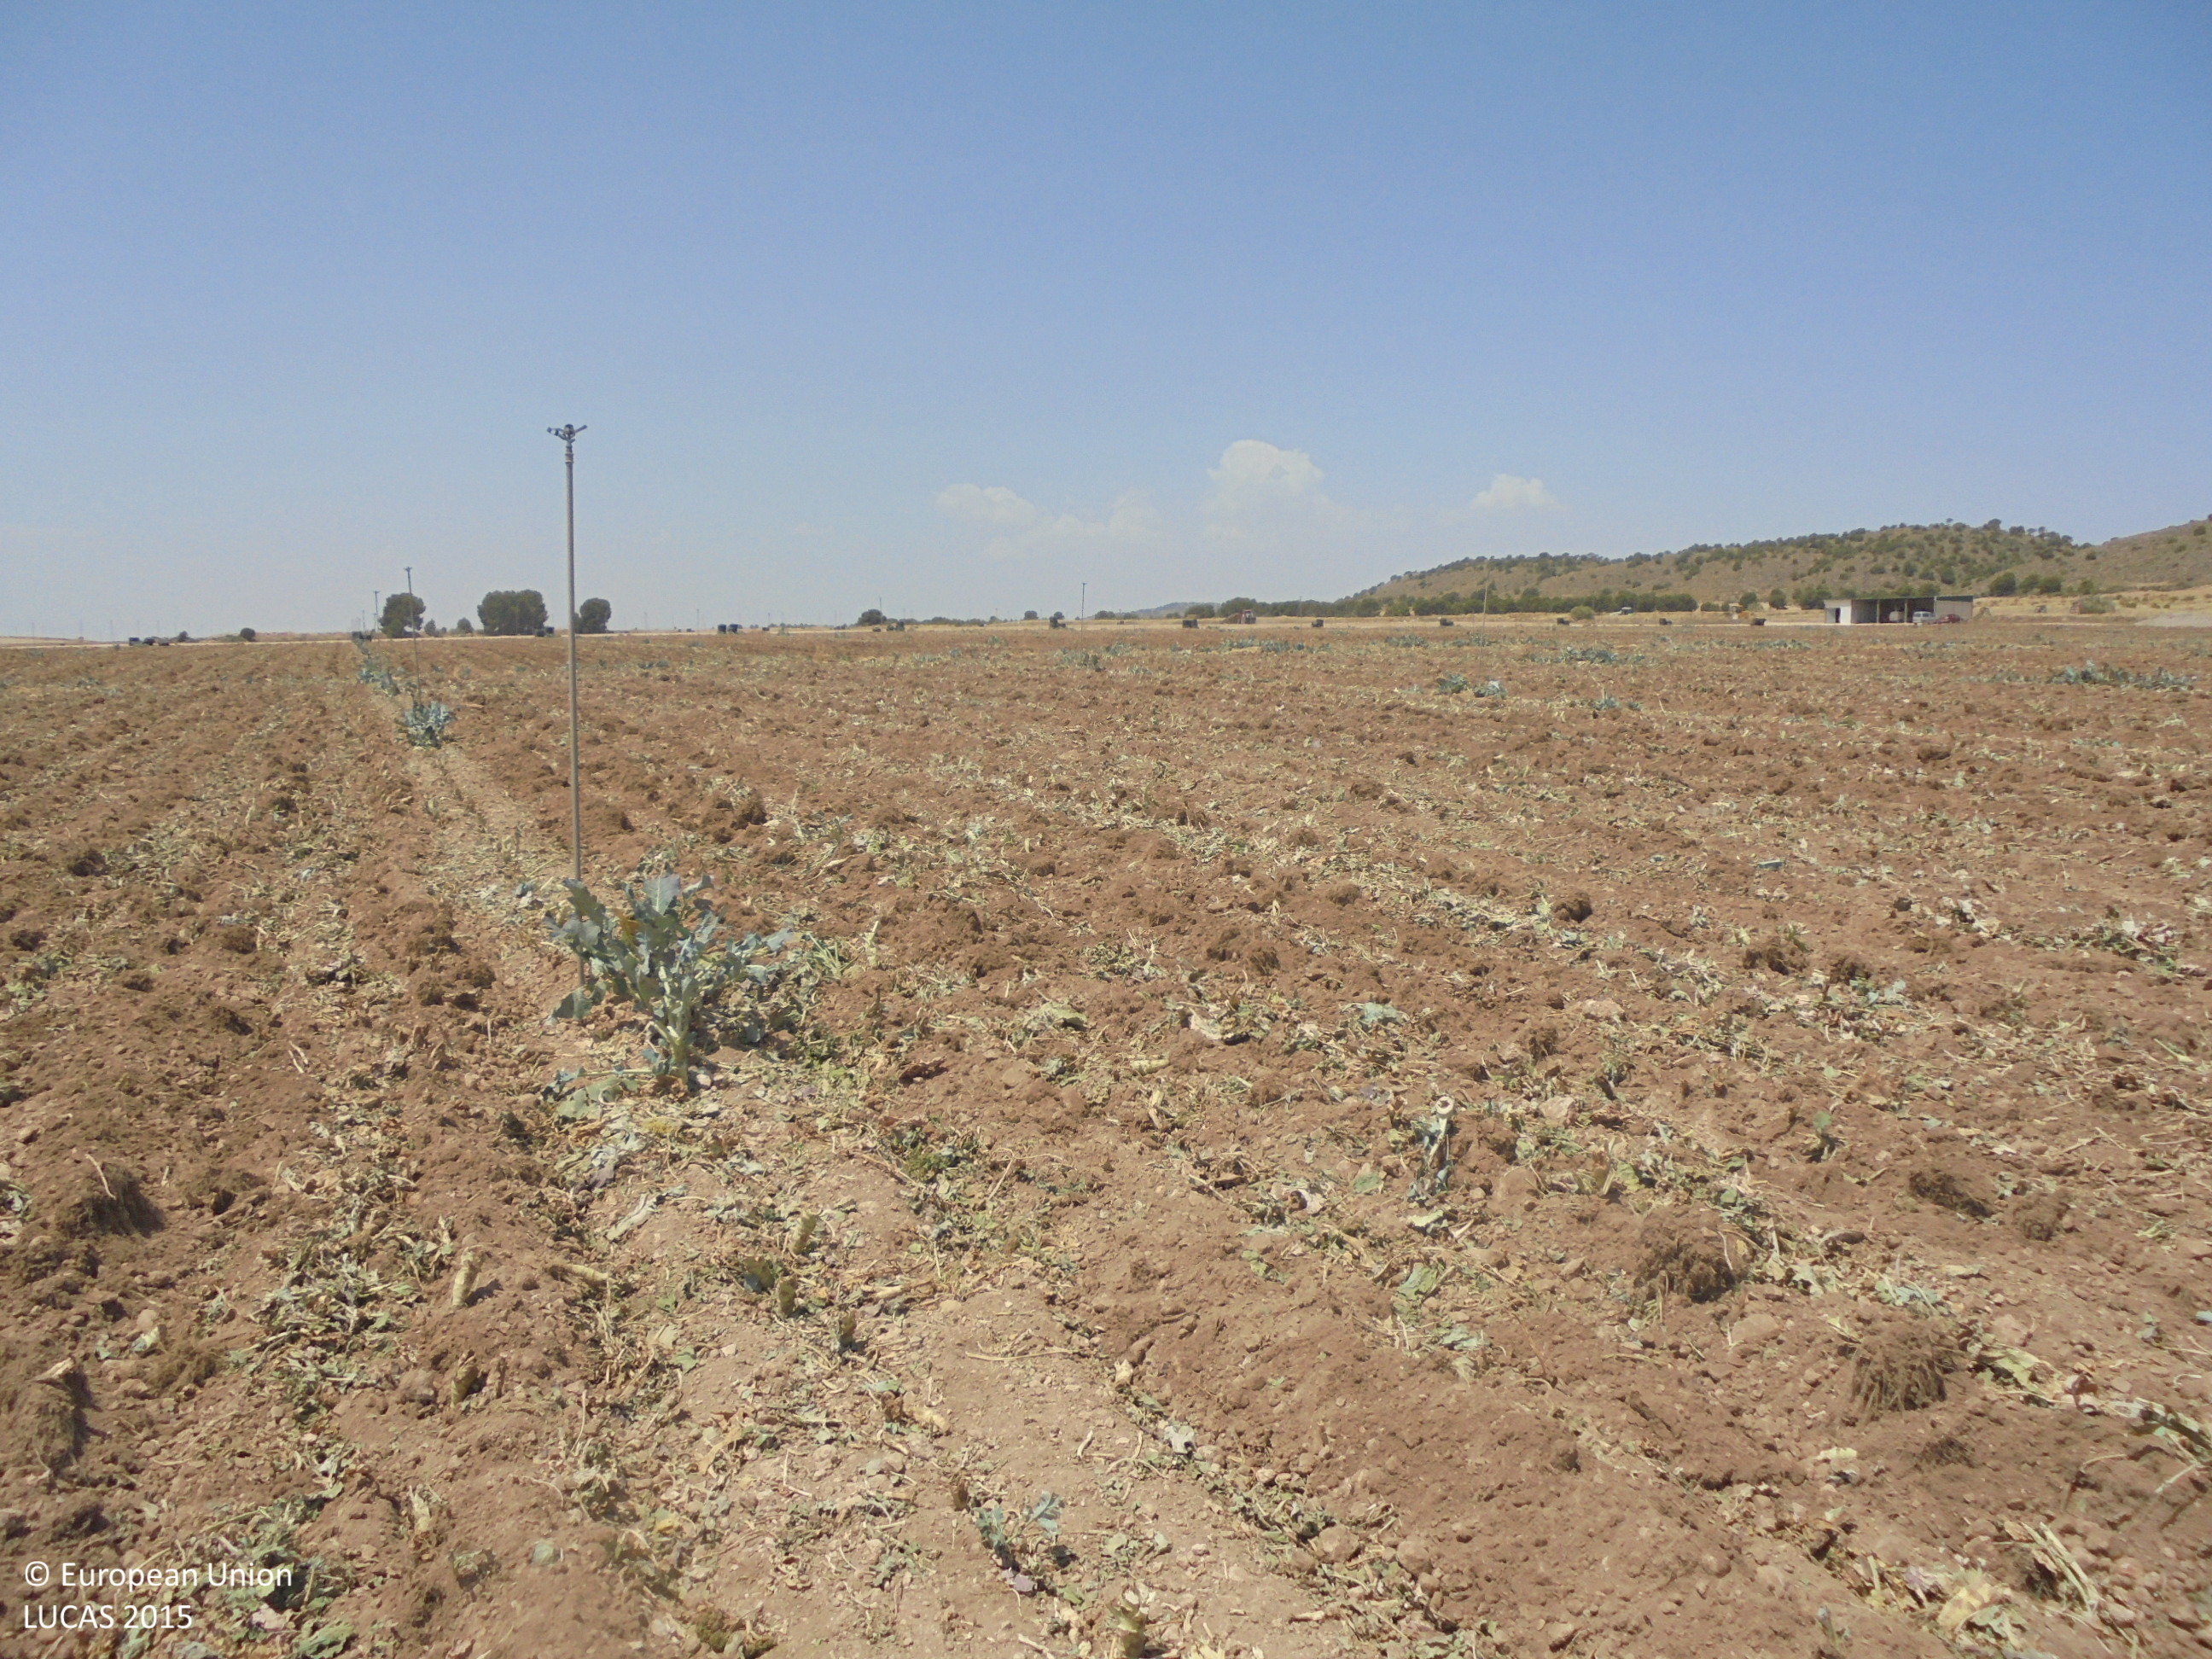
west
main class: Cropland
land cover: Other fresh vegetables
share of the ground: < 10 %
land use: Agriculture (excluding fallow land and kitchen gardens)
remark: Harvested field
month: July
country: ES
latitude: 38.6712
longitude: -1.6843
